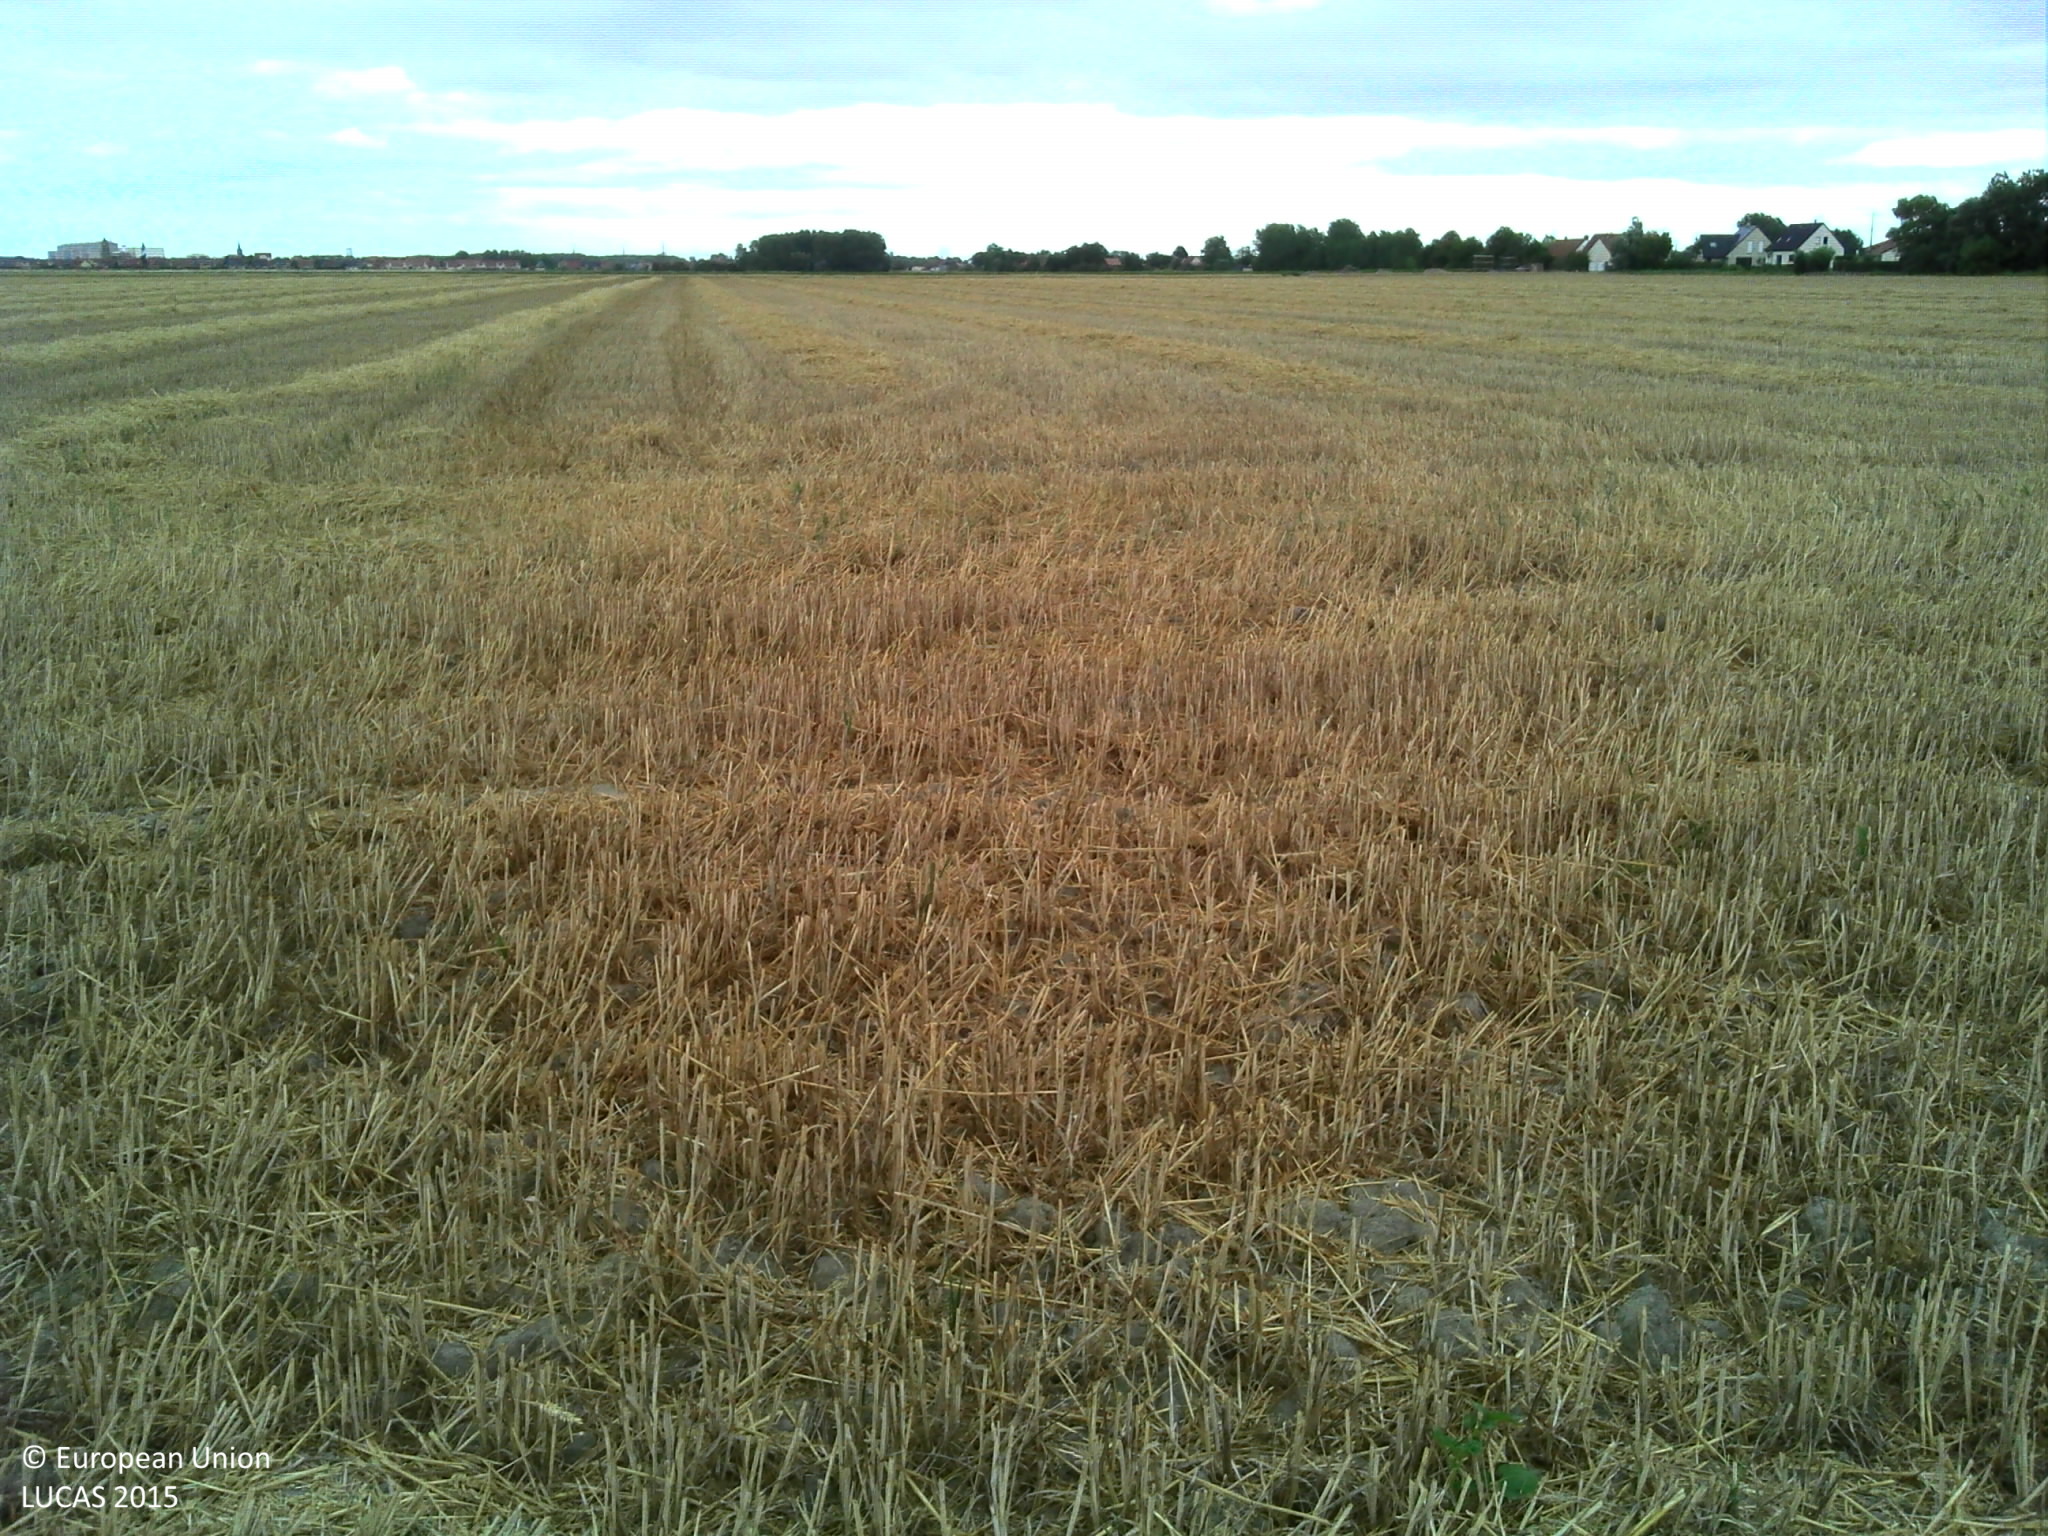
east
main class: Cropland
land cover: Common wheat
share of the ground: 50 - 75 %
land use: Agriculture (excluding fallow land and kitchen gardens)
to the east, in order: Common wheat
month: August
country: FR
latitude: 50.9924
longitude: 2.0773
